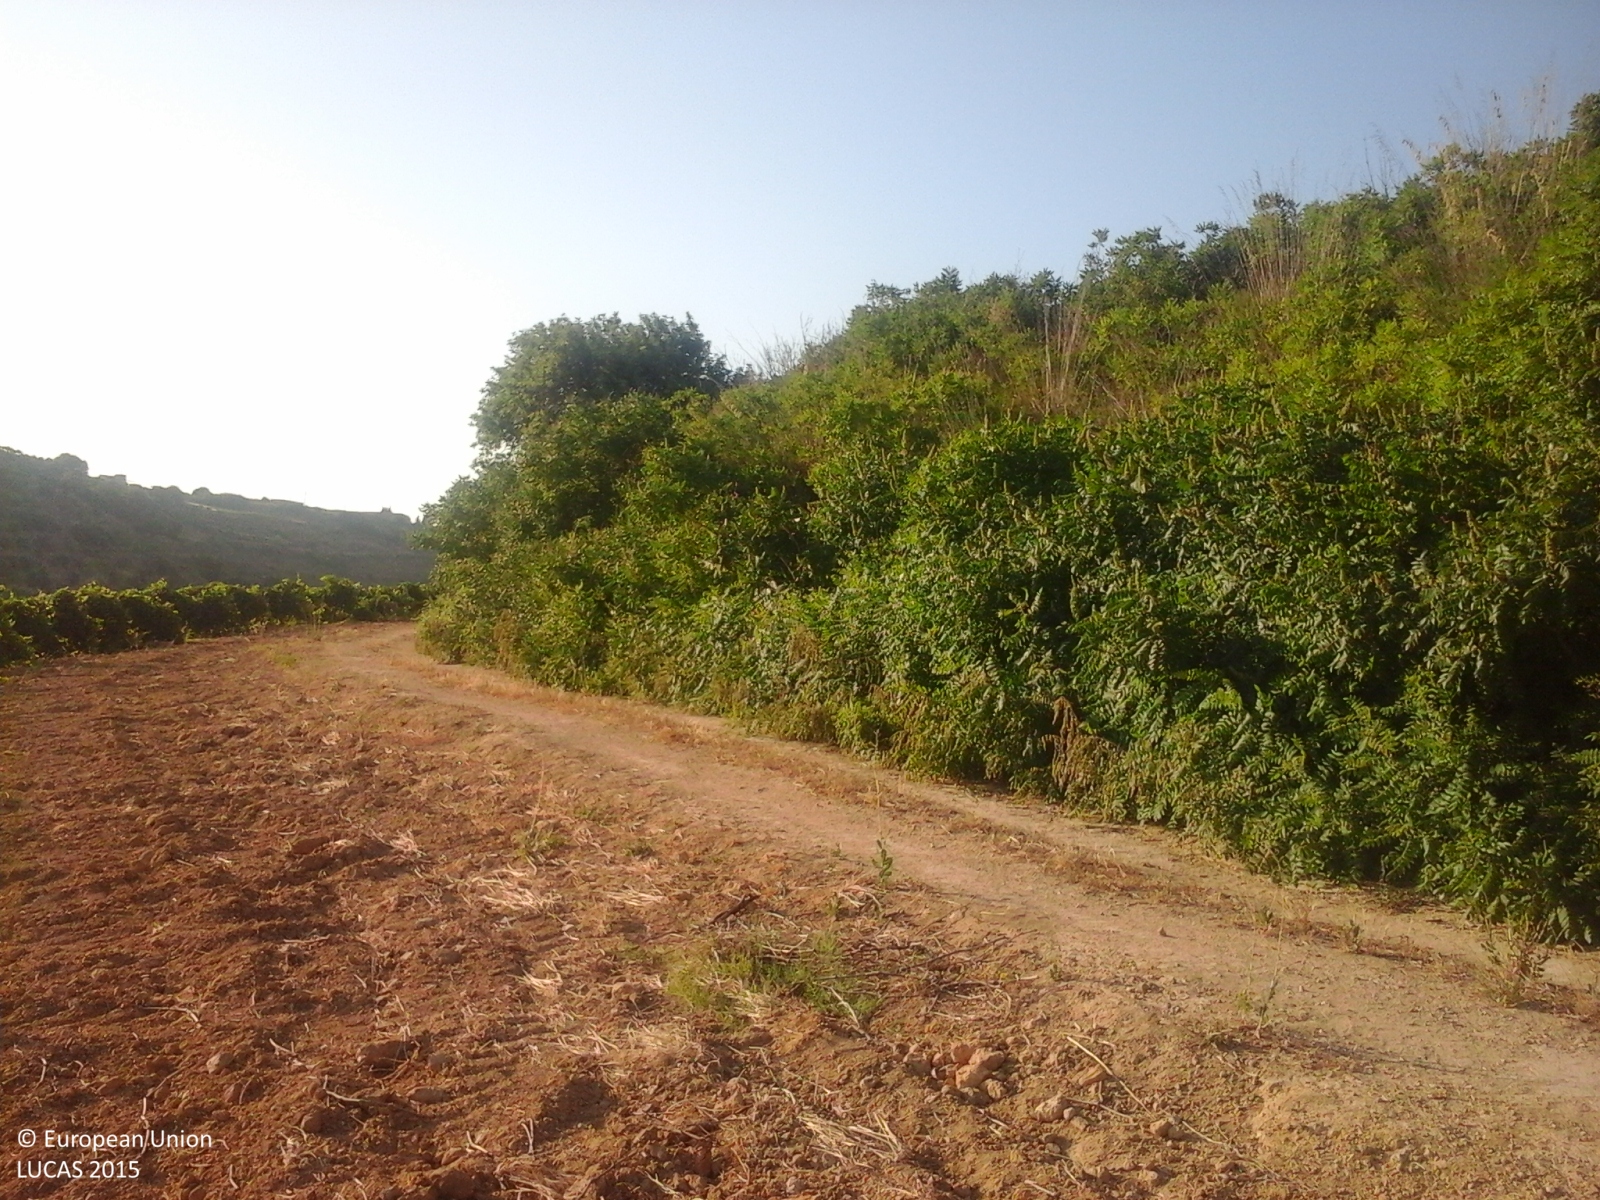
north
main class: Cropland
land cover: Vineyards
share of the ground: 10 - 25 %
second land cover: Other bare soil
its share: > 75 %
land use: Agriculture (excluding fallow land and kitchen gardens)
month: May
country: IT
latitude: 37.6093
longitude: 13.0018
